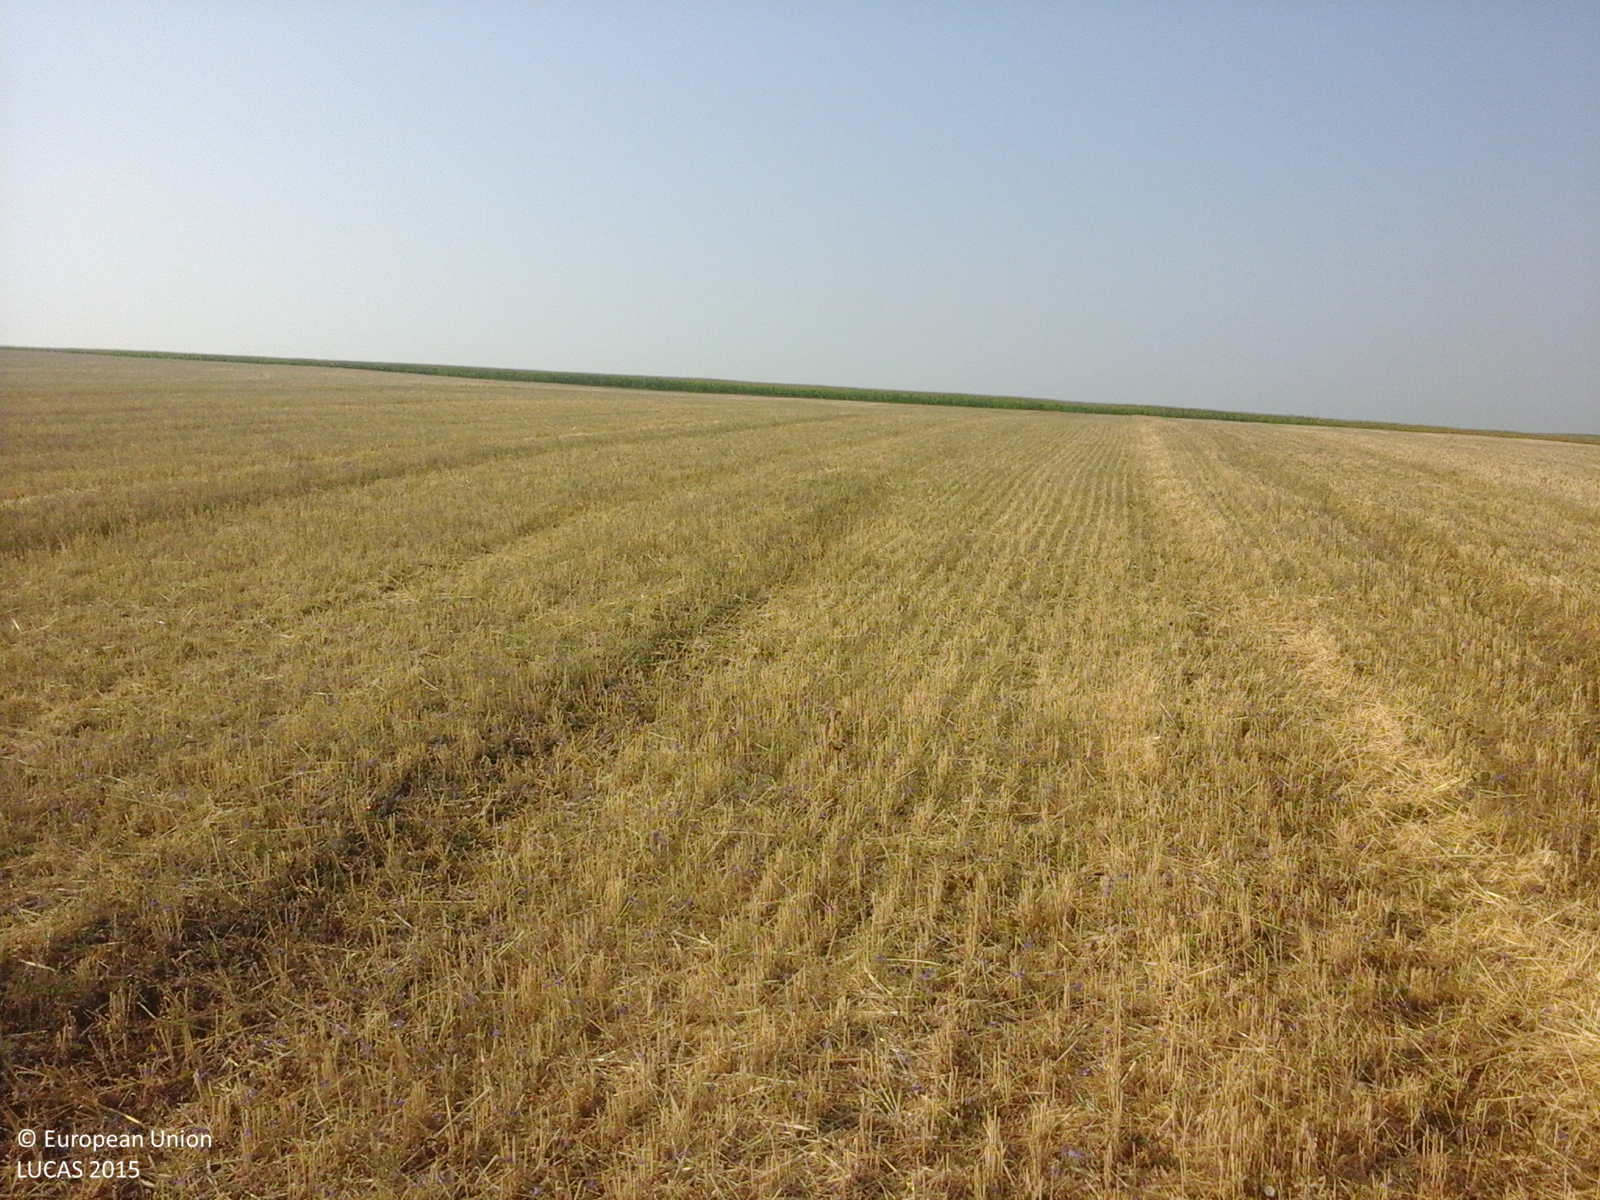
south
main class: Cropland
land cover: Common wheat
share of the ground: > 75 %
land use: Agriculture (excluding fallow land and kitchen gardens)
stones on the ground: < 10 %
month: July
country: RO
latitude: 45.7913
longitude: 27.8555
